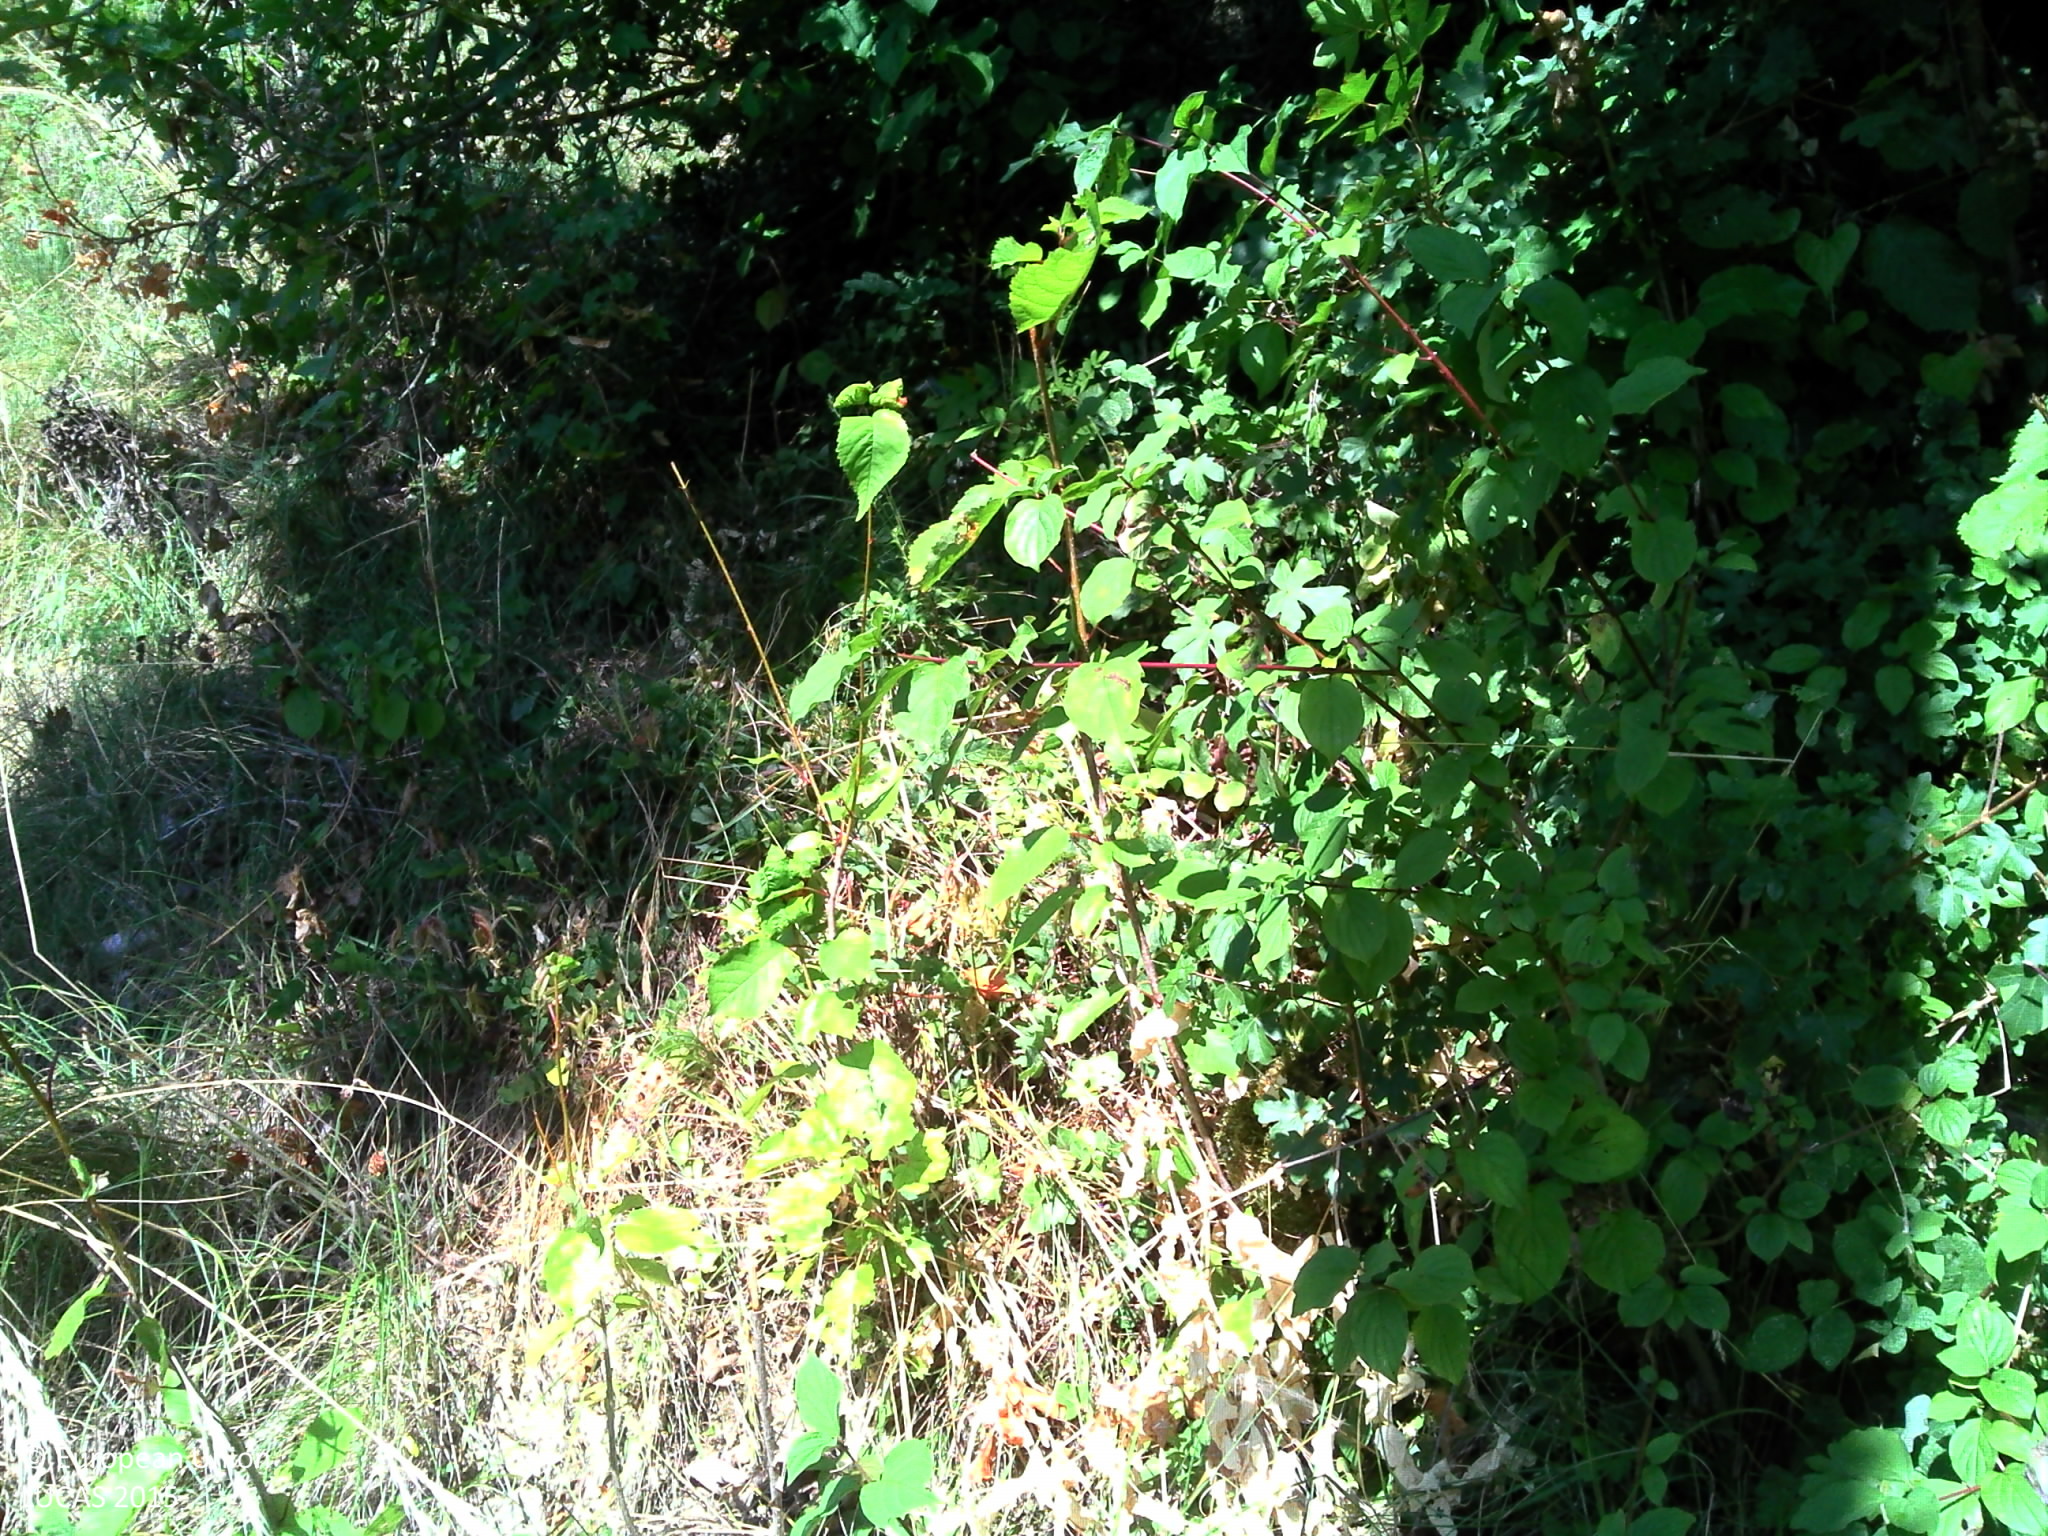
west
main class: Shrubland
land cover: Shrubland without tree cover
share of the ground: > 75 %
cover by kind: herbaceous plants 65 %, shrubs 35 %
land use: Agriculture (excluding fallow land and kitchen gardens)
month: July
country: FR
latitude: 45.2982
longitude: 5.4526
